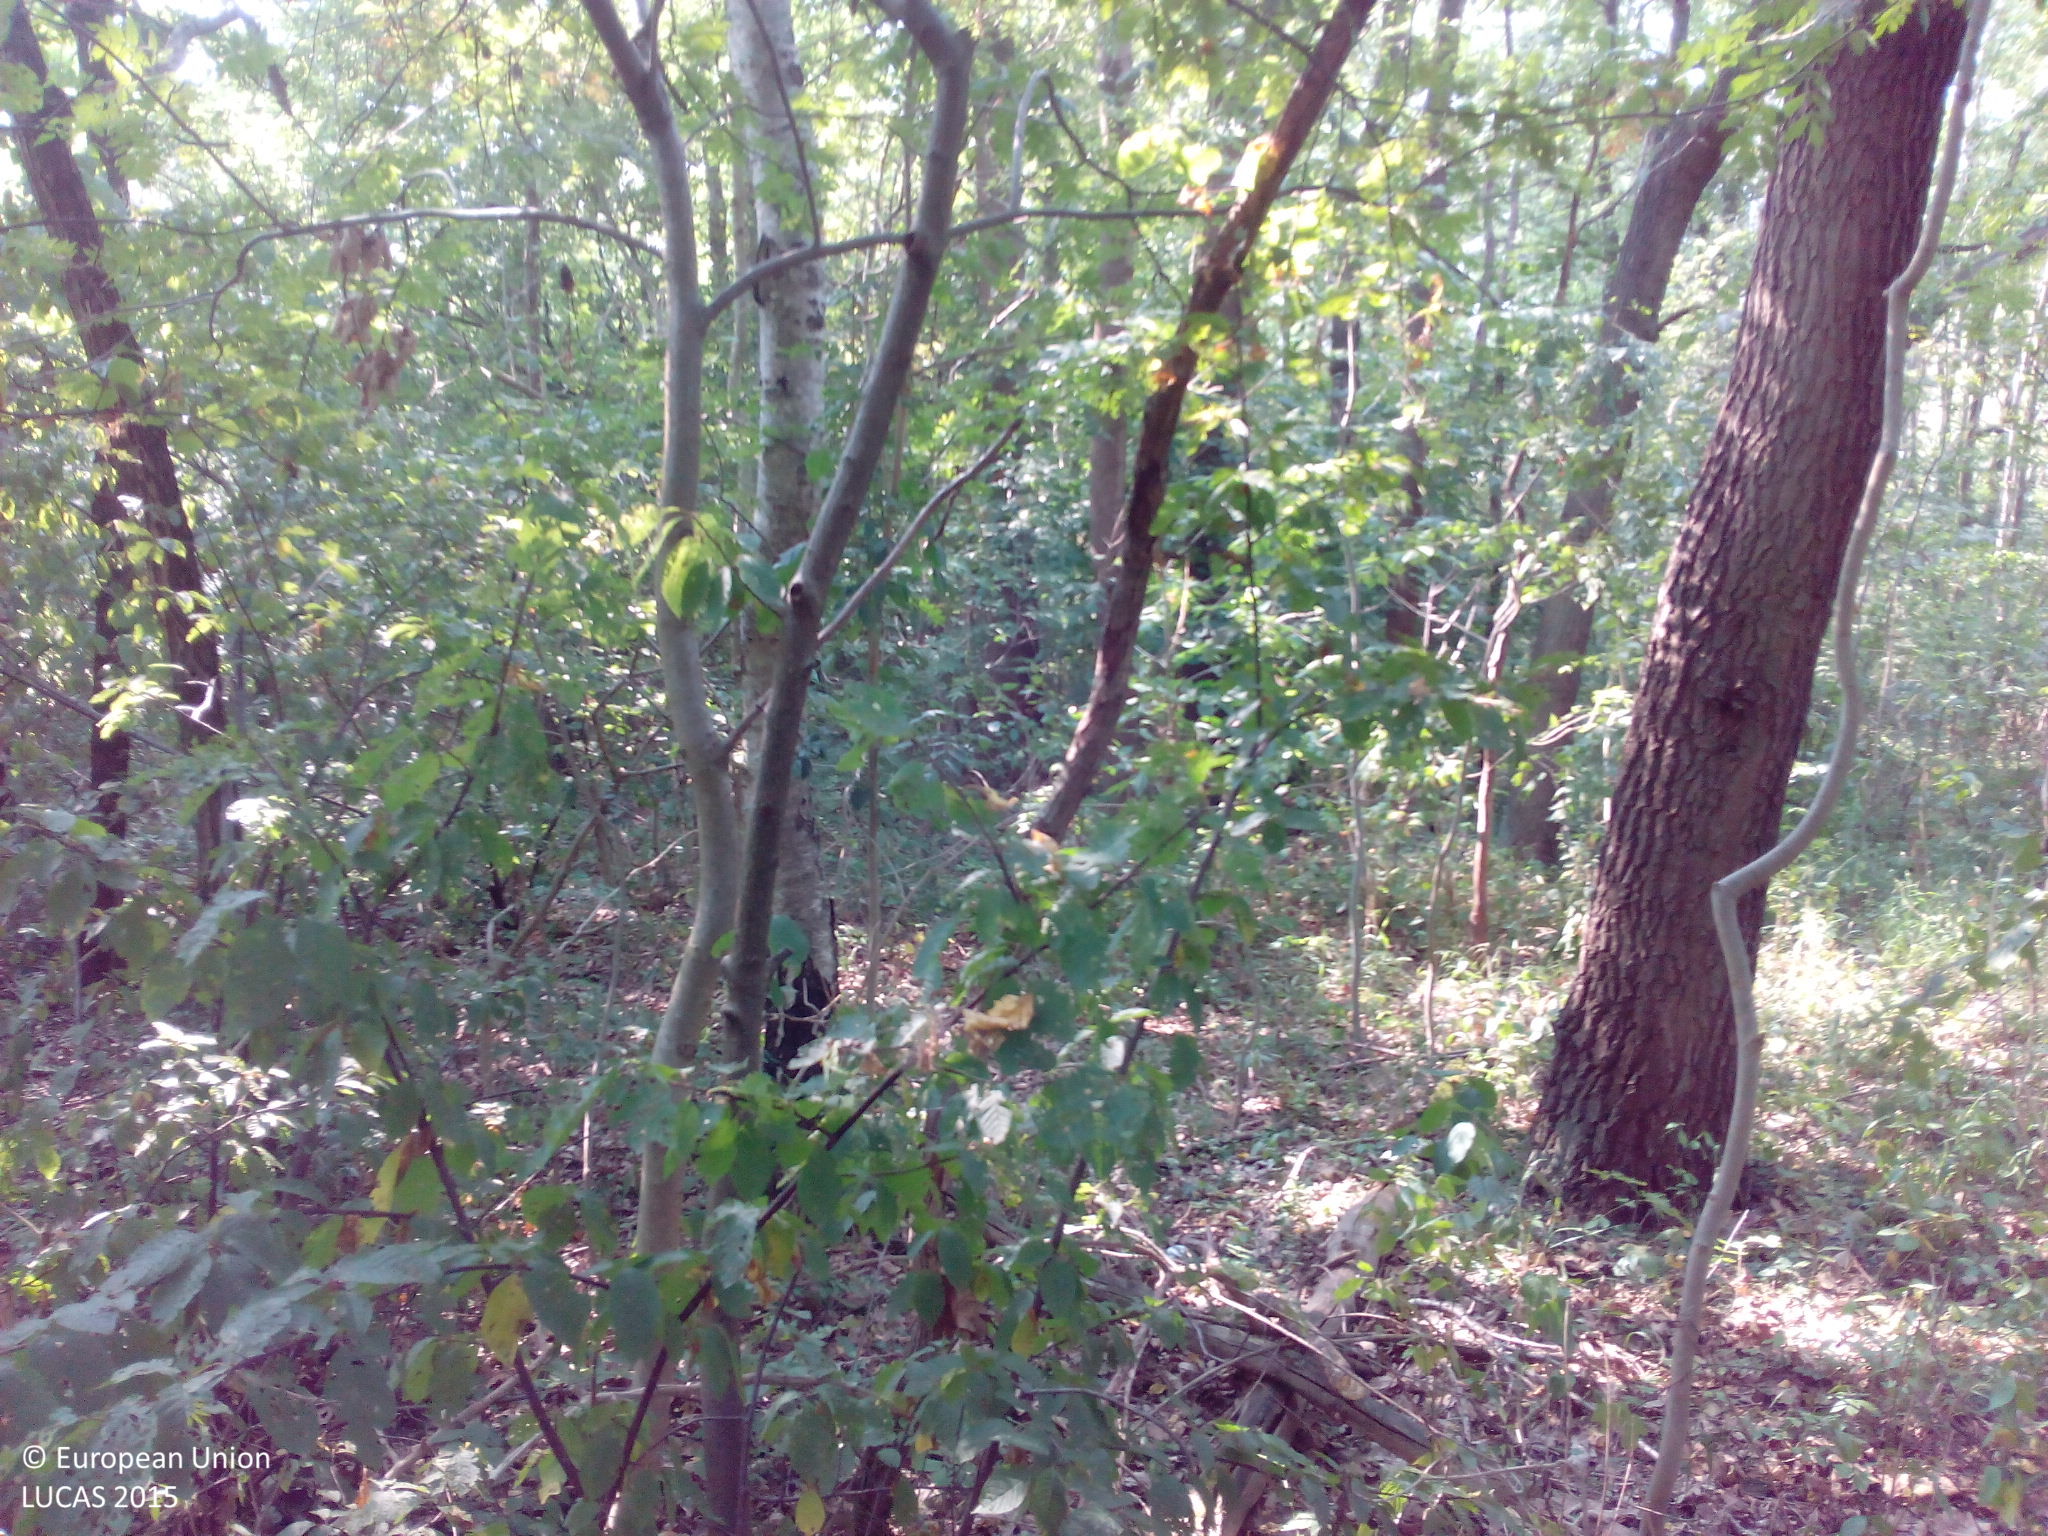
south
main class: Woodland
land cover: Broadleaved woodland
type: mesophytic deciduous forest
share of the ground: > 75 %
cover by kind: broadleaved forest trees 100 %
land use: Forestry
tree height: > 5 m
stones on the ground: < 10 %
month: August
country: DE
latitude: 51.7576
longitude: 12.5061
